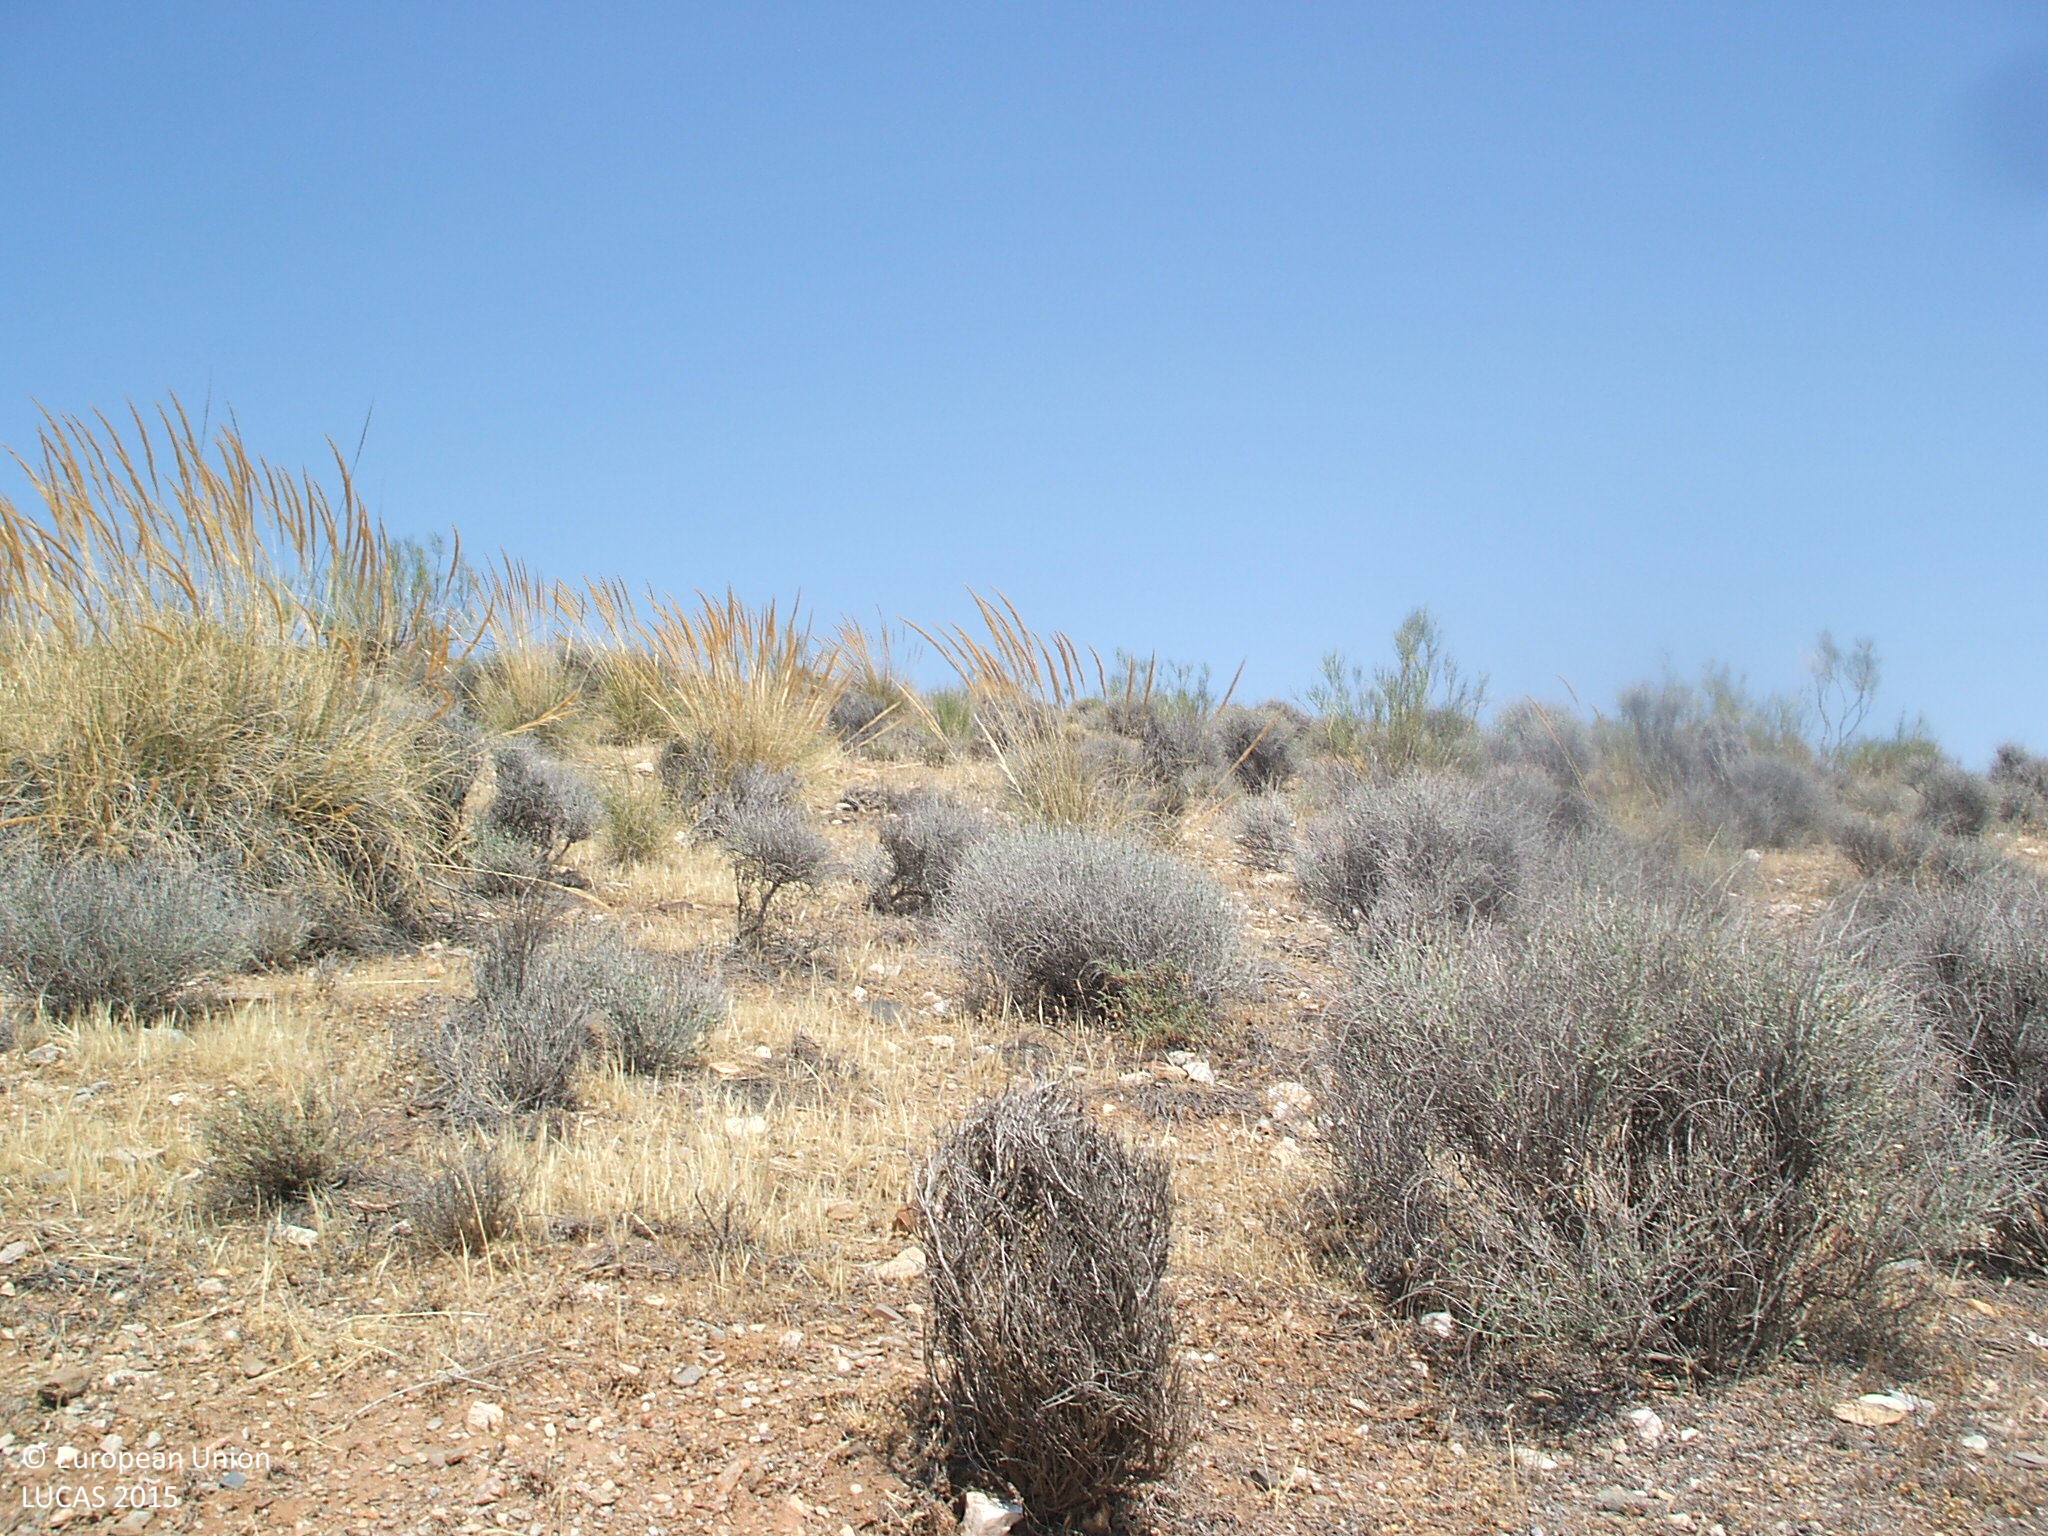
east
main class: Shrubland
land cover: Shrubland without tree cover
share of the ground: 50 - 75 %
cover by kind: shrubs 60 %, consolidated bare surface 40 %
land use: Semi-natural and natural areas not in use
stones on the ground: > 50 %
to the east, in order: Shrubland without tree cover; Rivers and streams; Pine dominated coniferous woodland
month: June
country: ES
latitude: 37.2004
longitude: -2.8611
